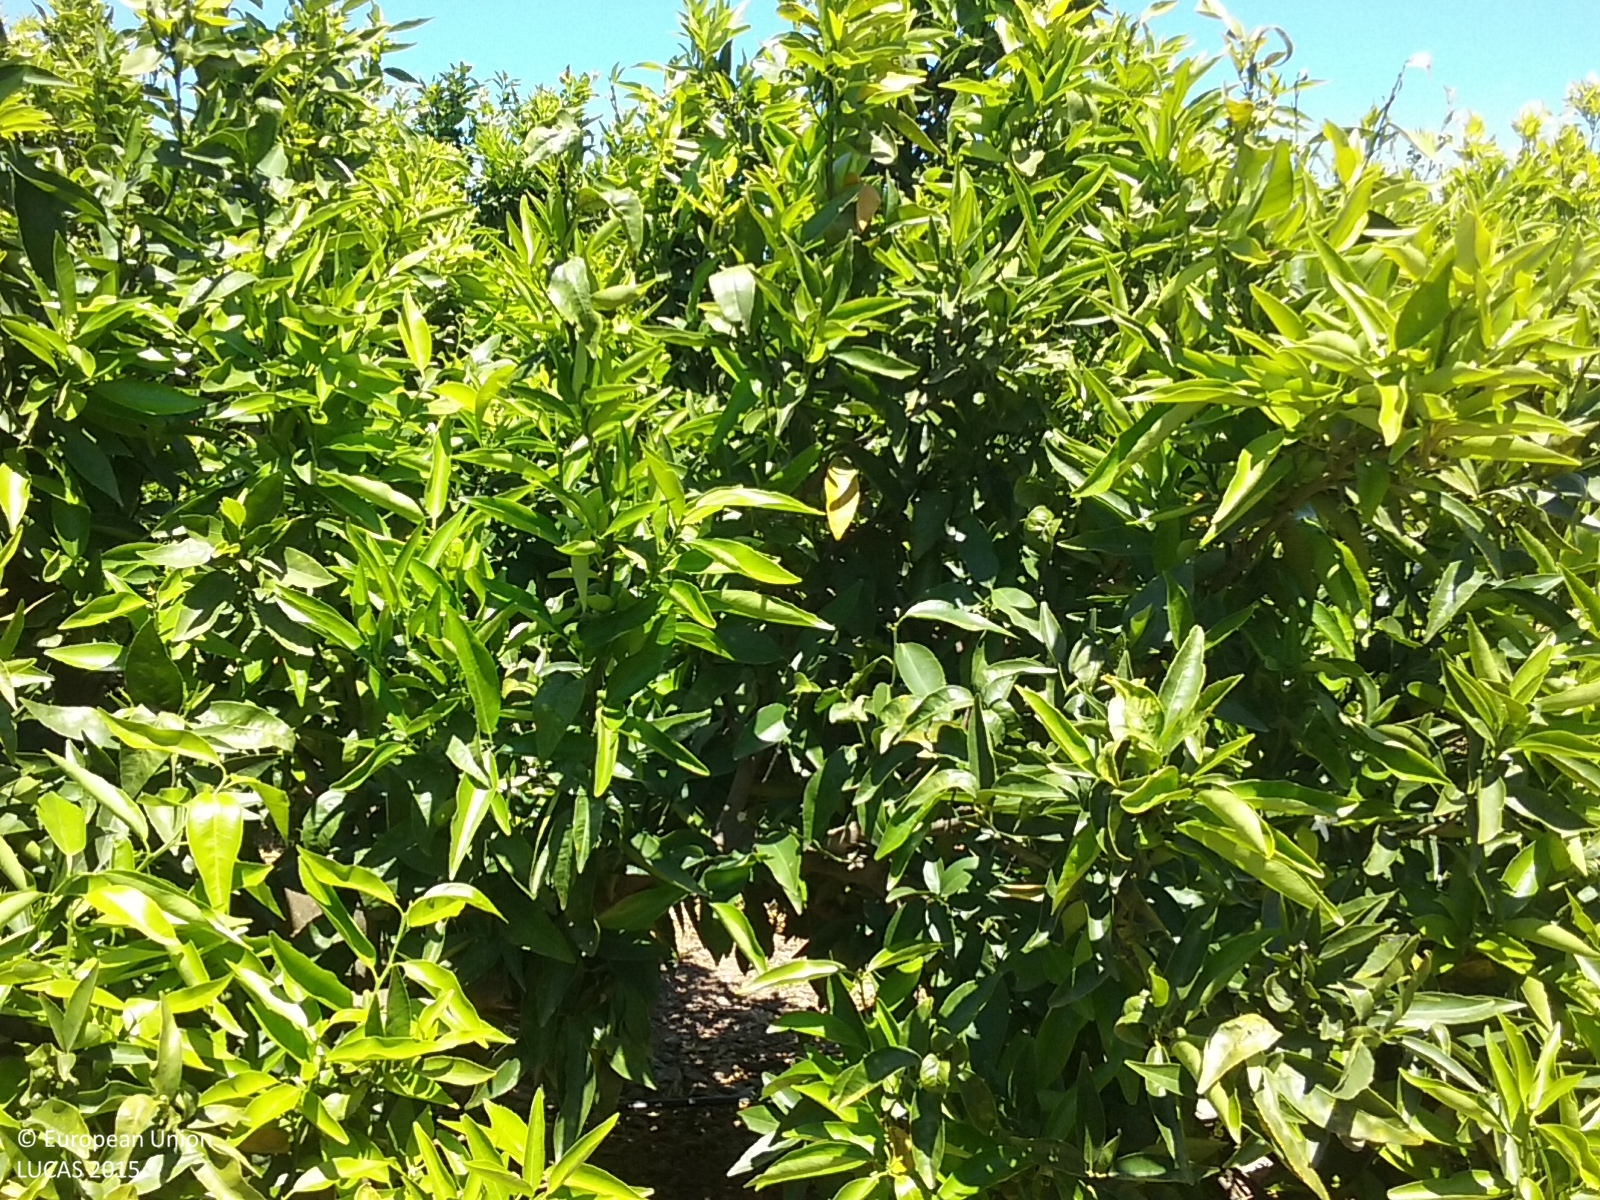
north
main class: Cropland
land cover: Oranges
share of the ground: 50 - 75 %
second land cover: Other bare soil
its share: > 75 %
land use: Agriculture (excluding fallow land and kitchen gardens)
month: May
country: ES
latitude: 40.7278
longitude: 0.4394
